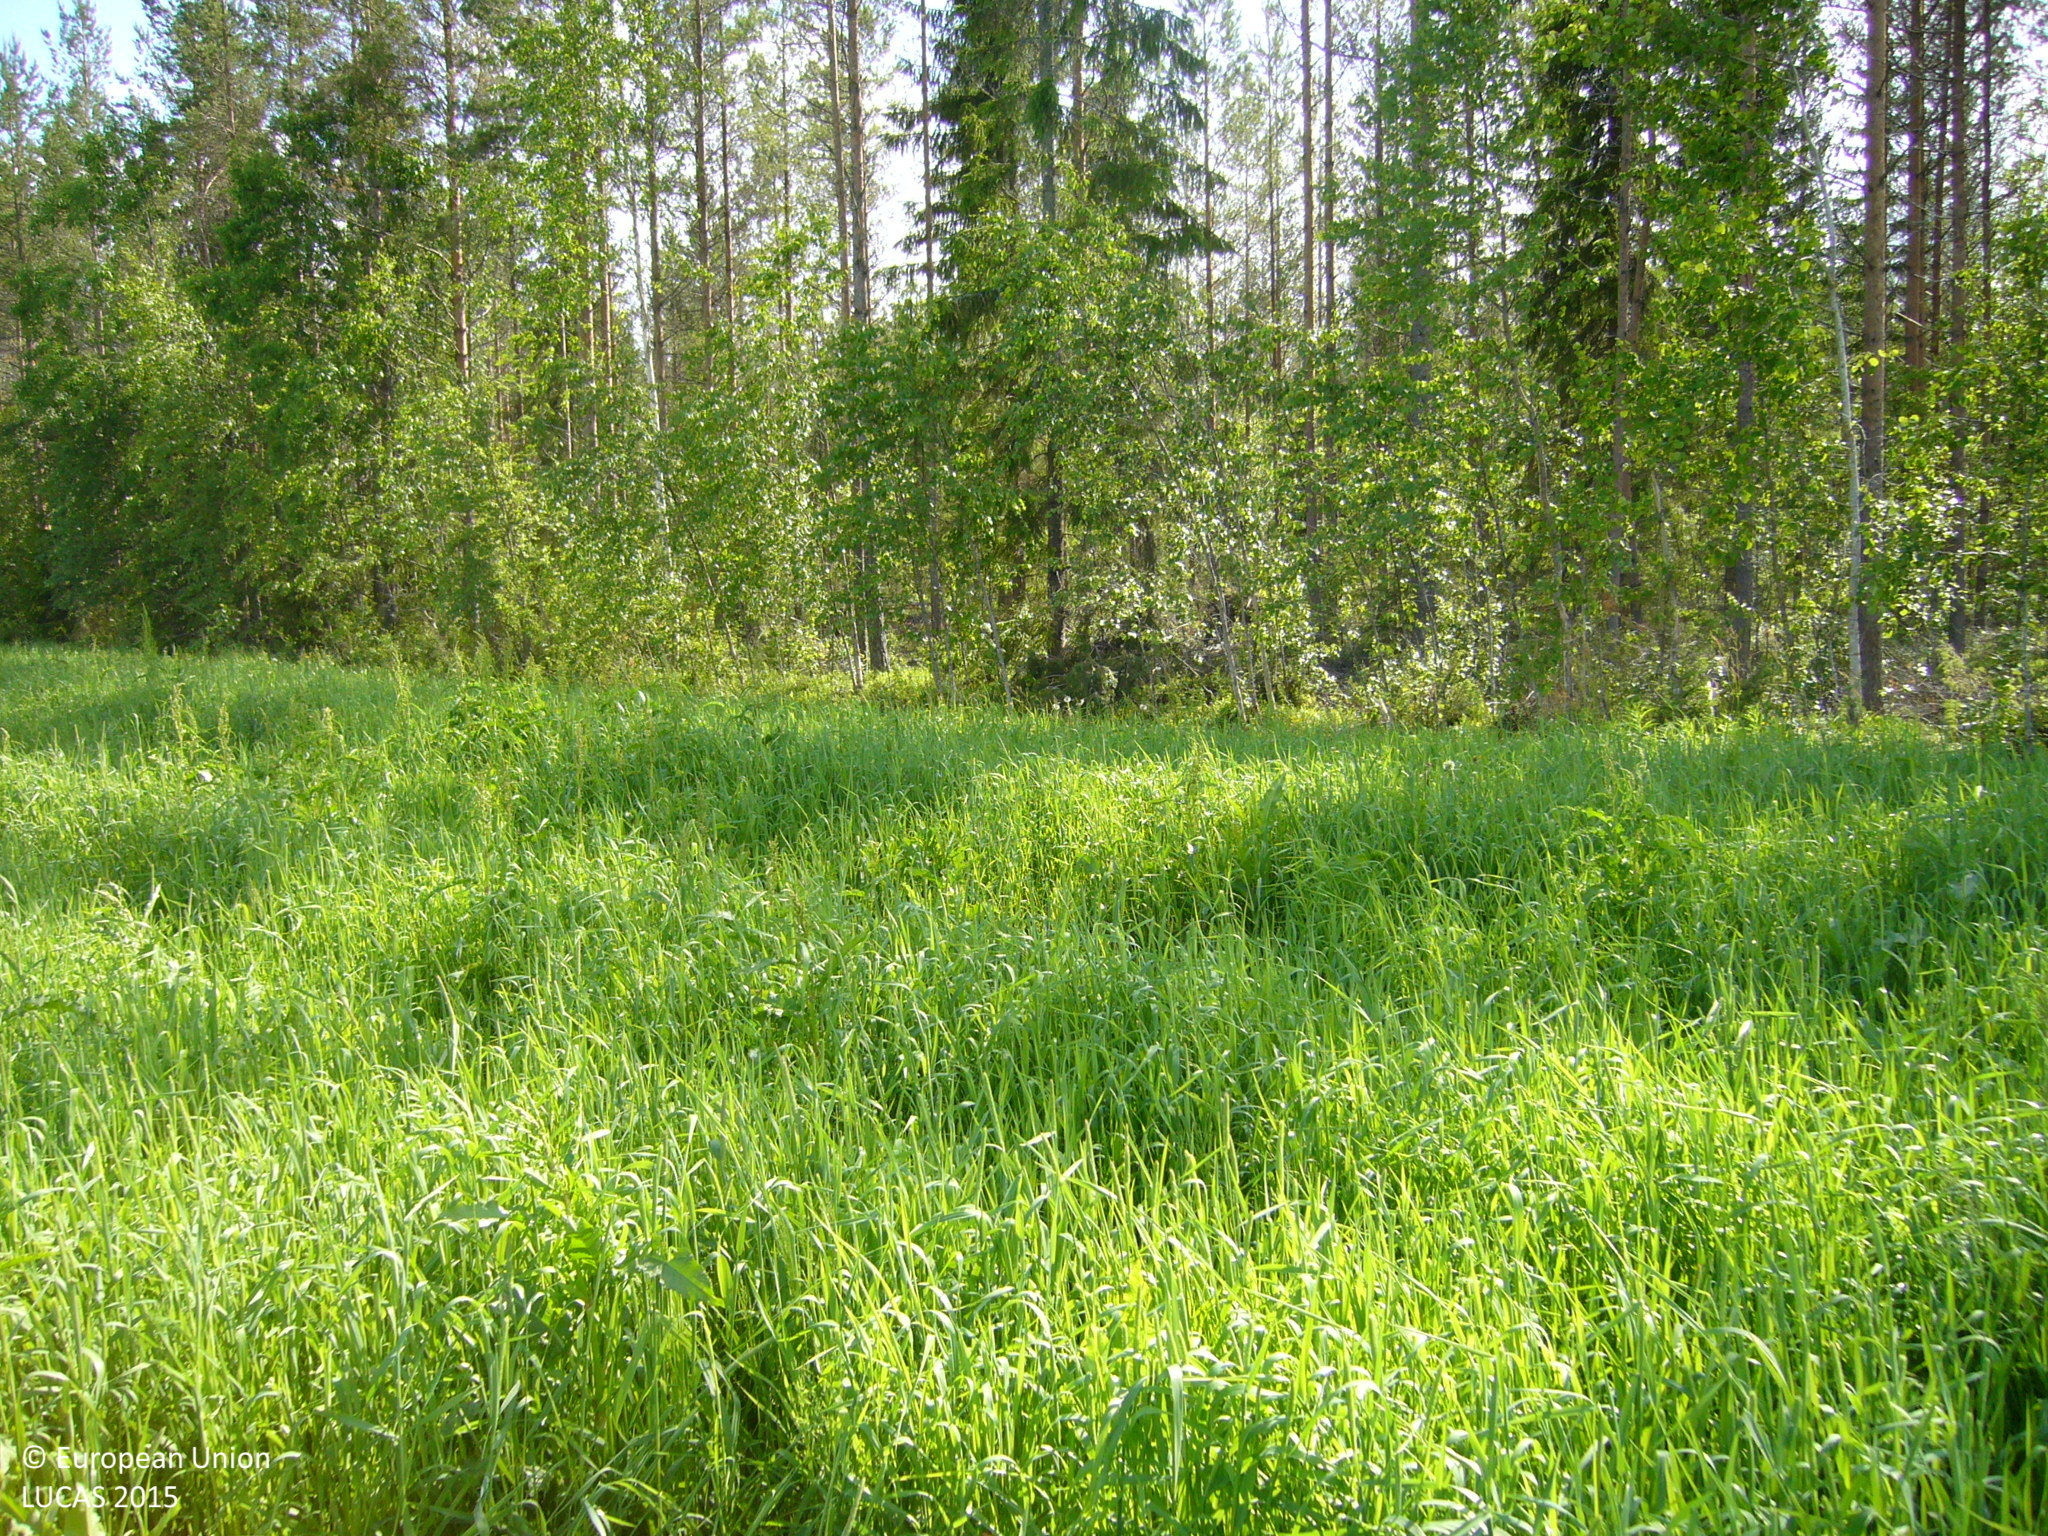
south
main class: Cropland
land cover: Temporary grasslands
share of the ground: > 75 %
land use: Agriculture (excluding fallow land and kitchen gardens)
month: June
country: FI
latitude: 63.7842
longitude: 26.3302
